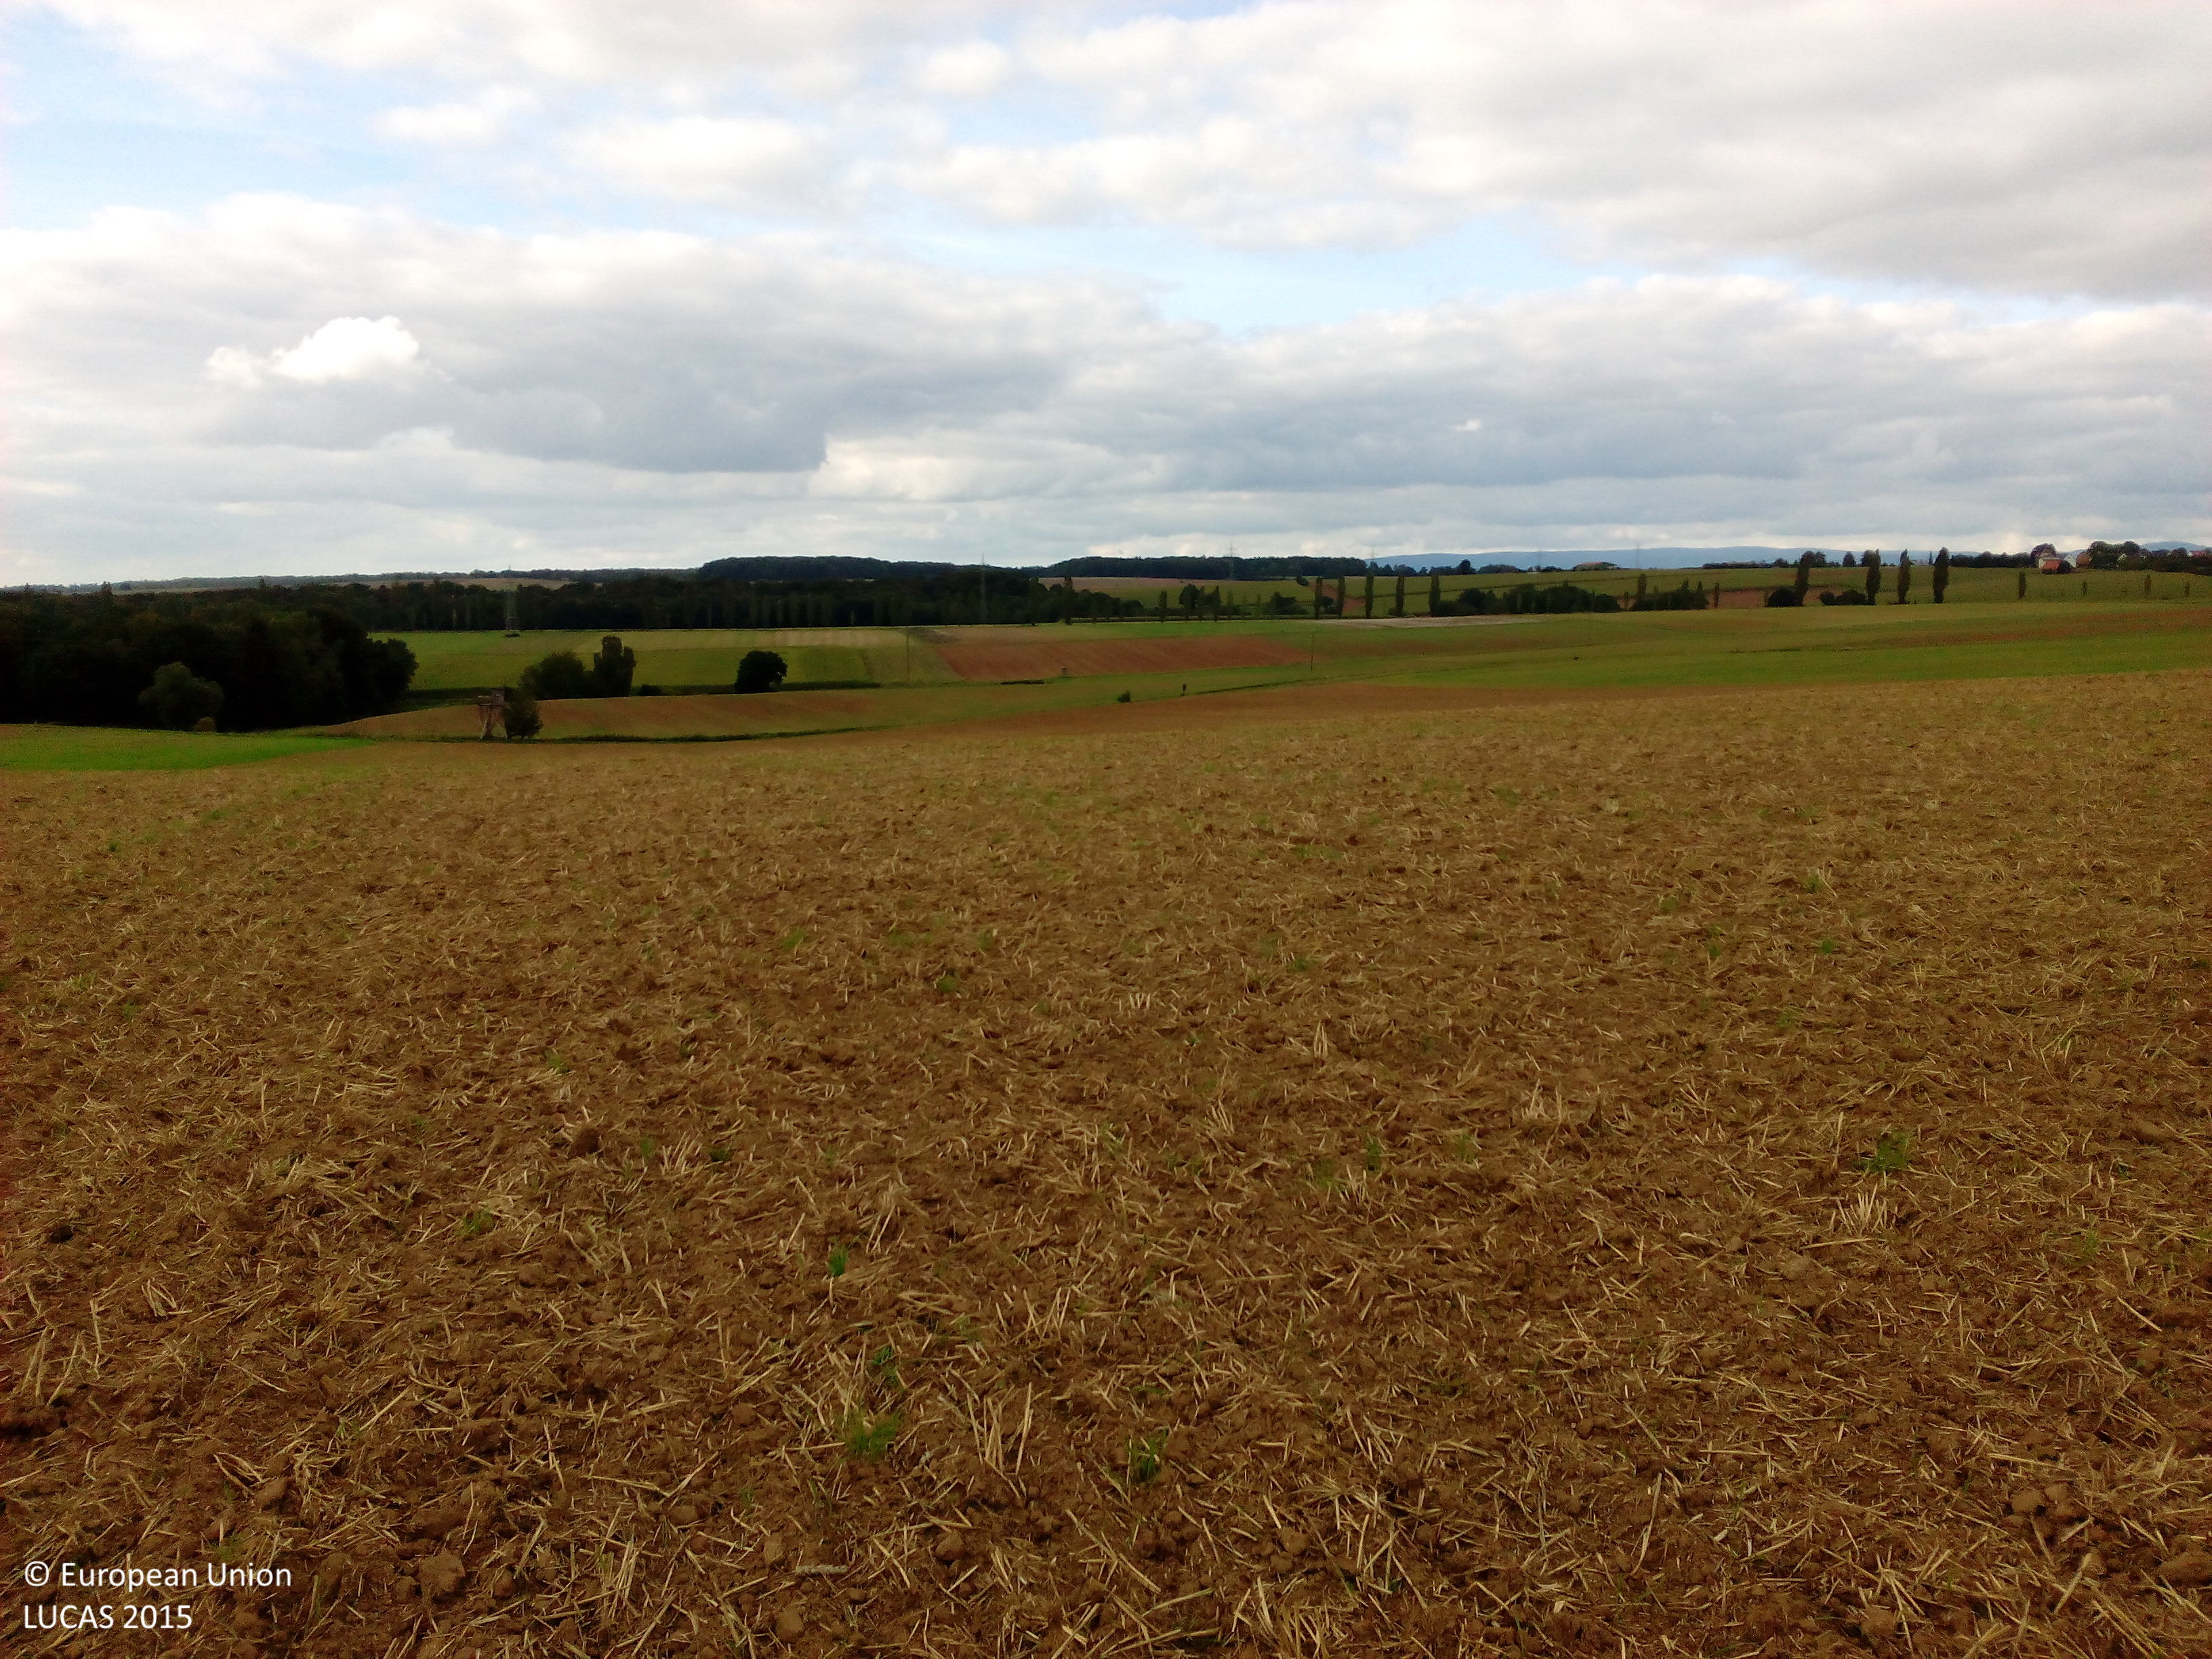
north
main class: Cropland
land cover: Common wheat
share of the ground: < 10 %
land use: Agriculture (excluding fallow land and kitchen gardens)
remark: Harvested field
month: September
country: DE
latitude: 51.5323
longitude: 10.2738
